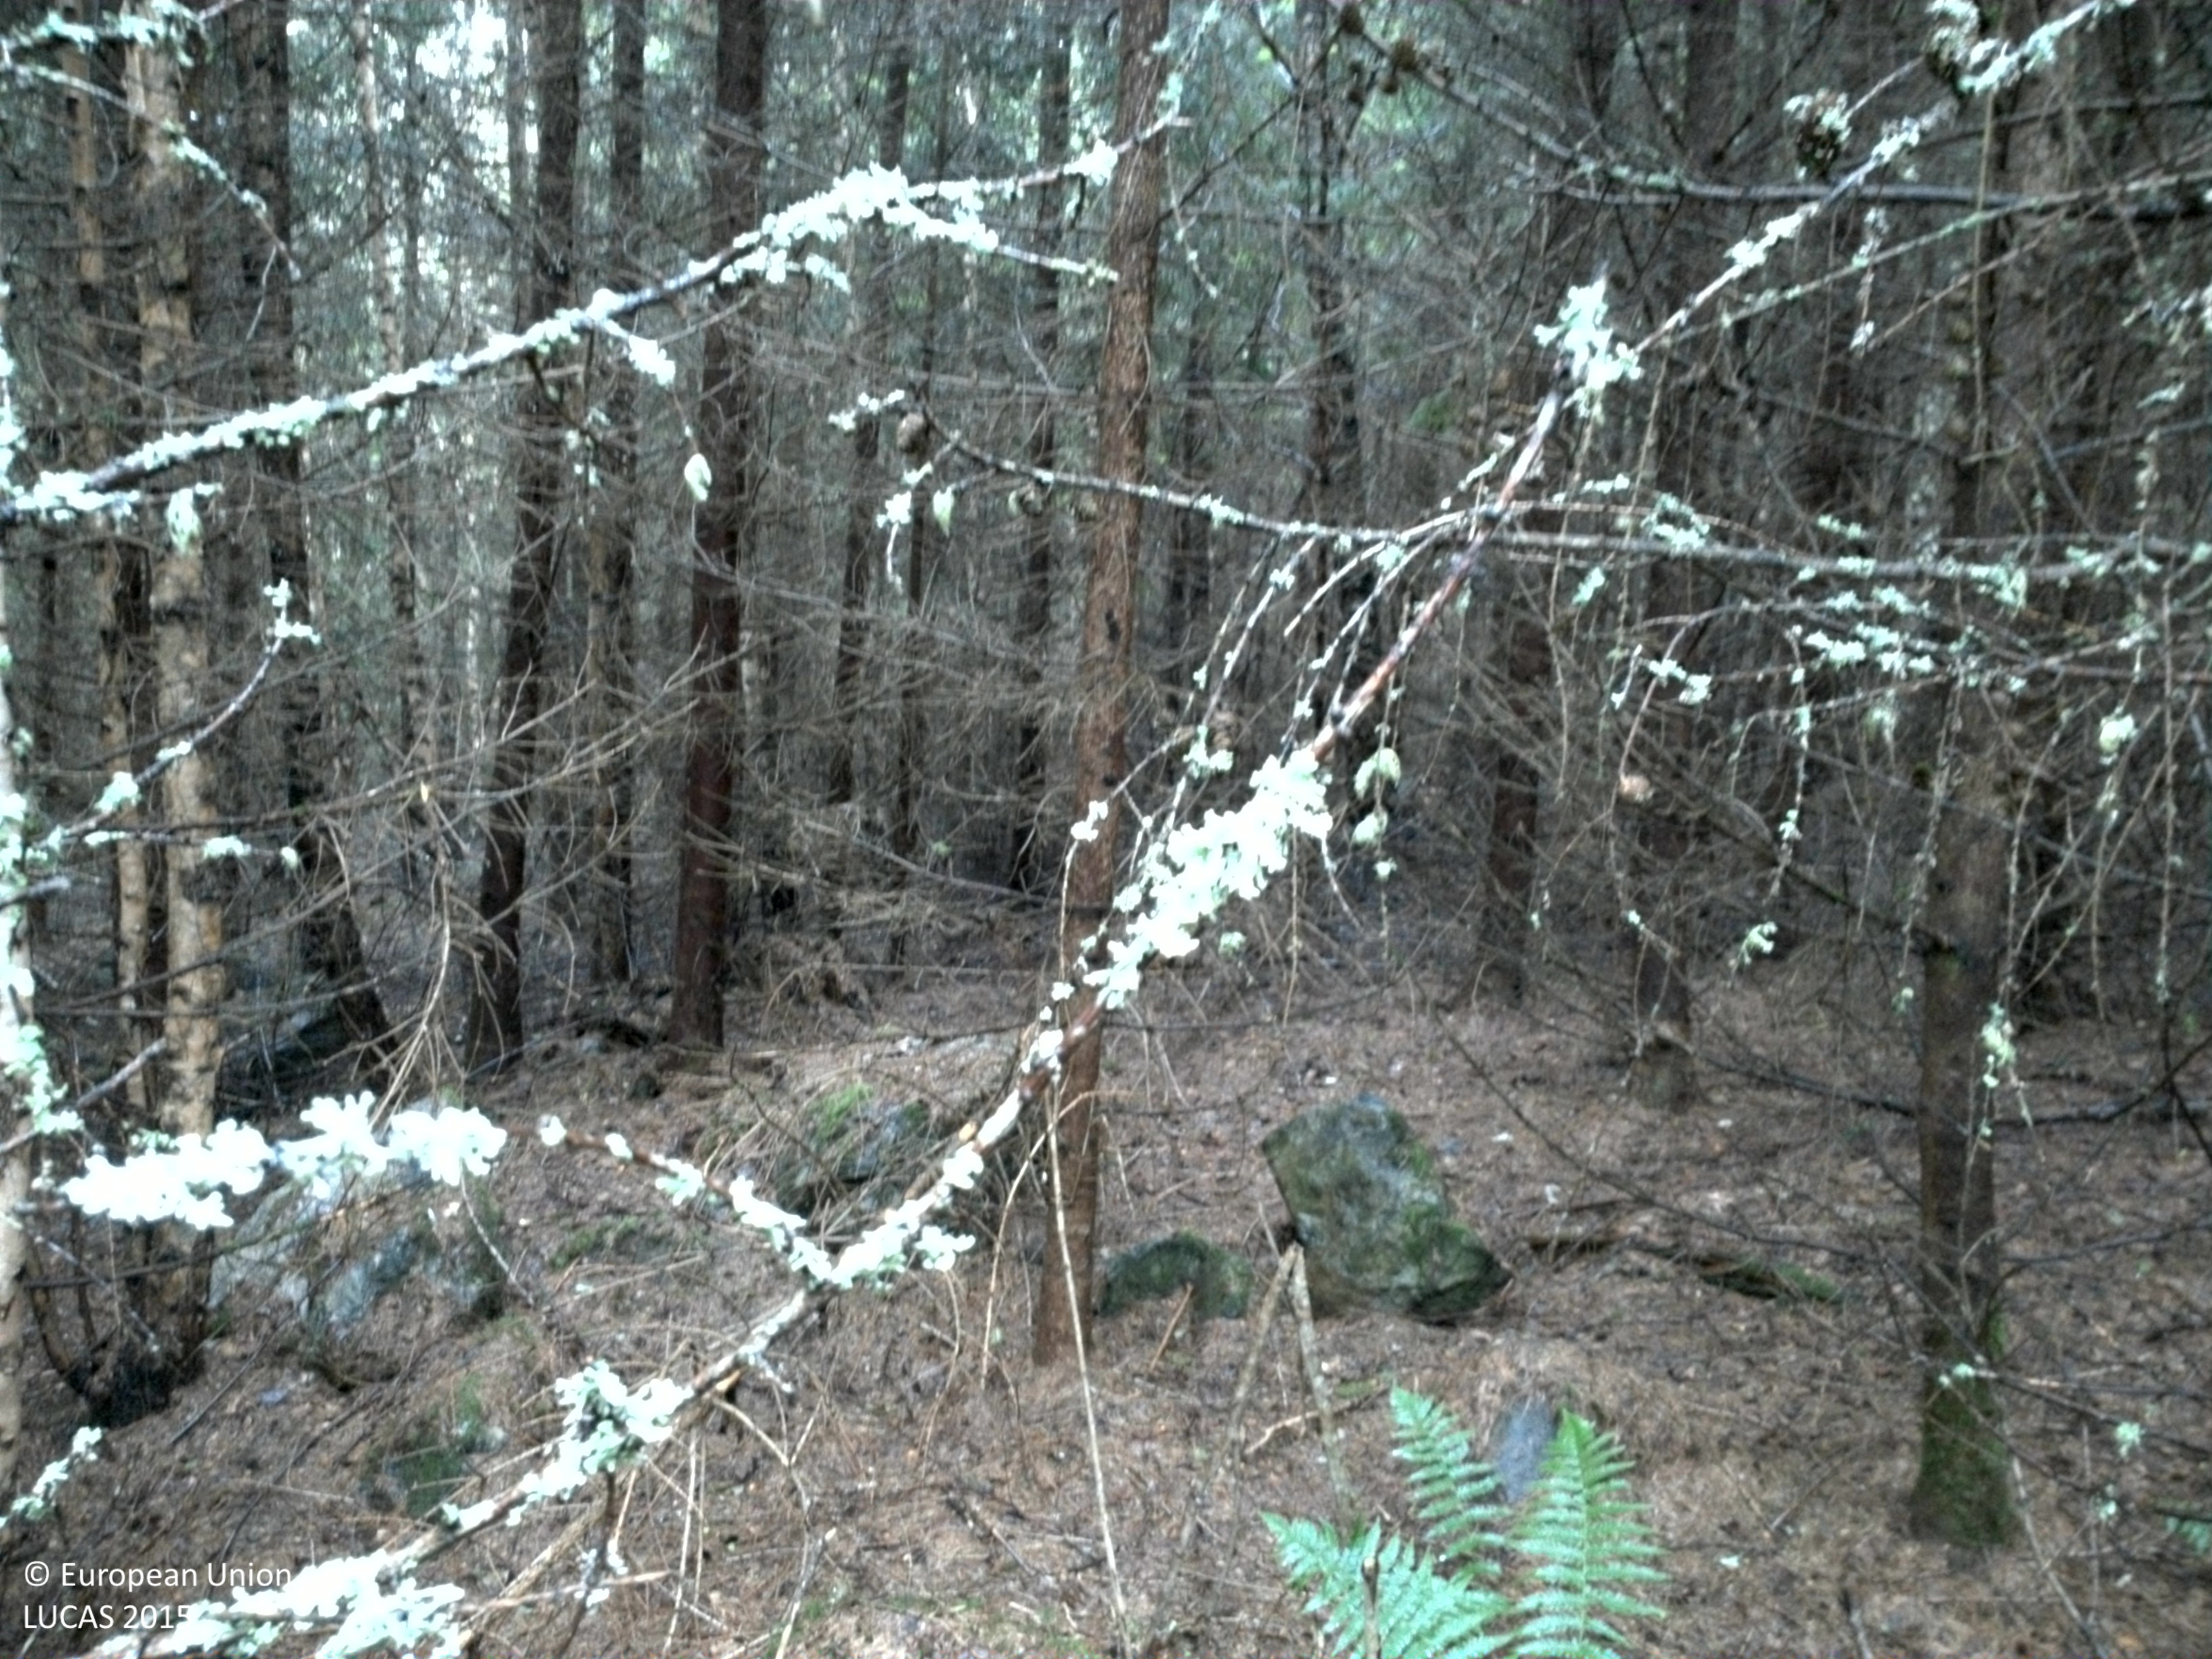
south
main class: Woodland
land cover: Spruce dominated coniferous woodland
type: boreal forest
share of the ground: 50 - 75 %
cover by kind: coniferous forest trees 70 %, consolidated bare surface 20 %, herbaceous plants 10 %
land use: Forestry
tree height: > 5 m
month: June
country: SE
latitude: 58.7215
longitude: 15.4675
